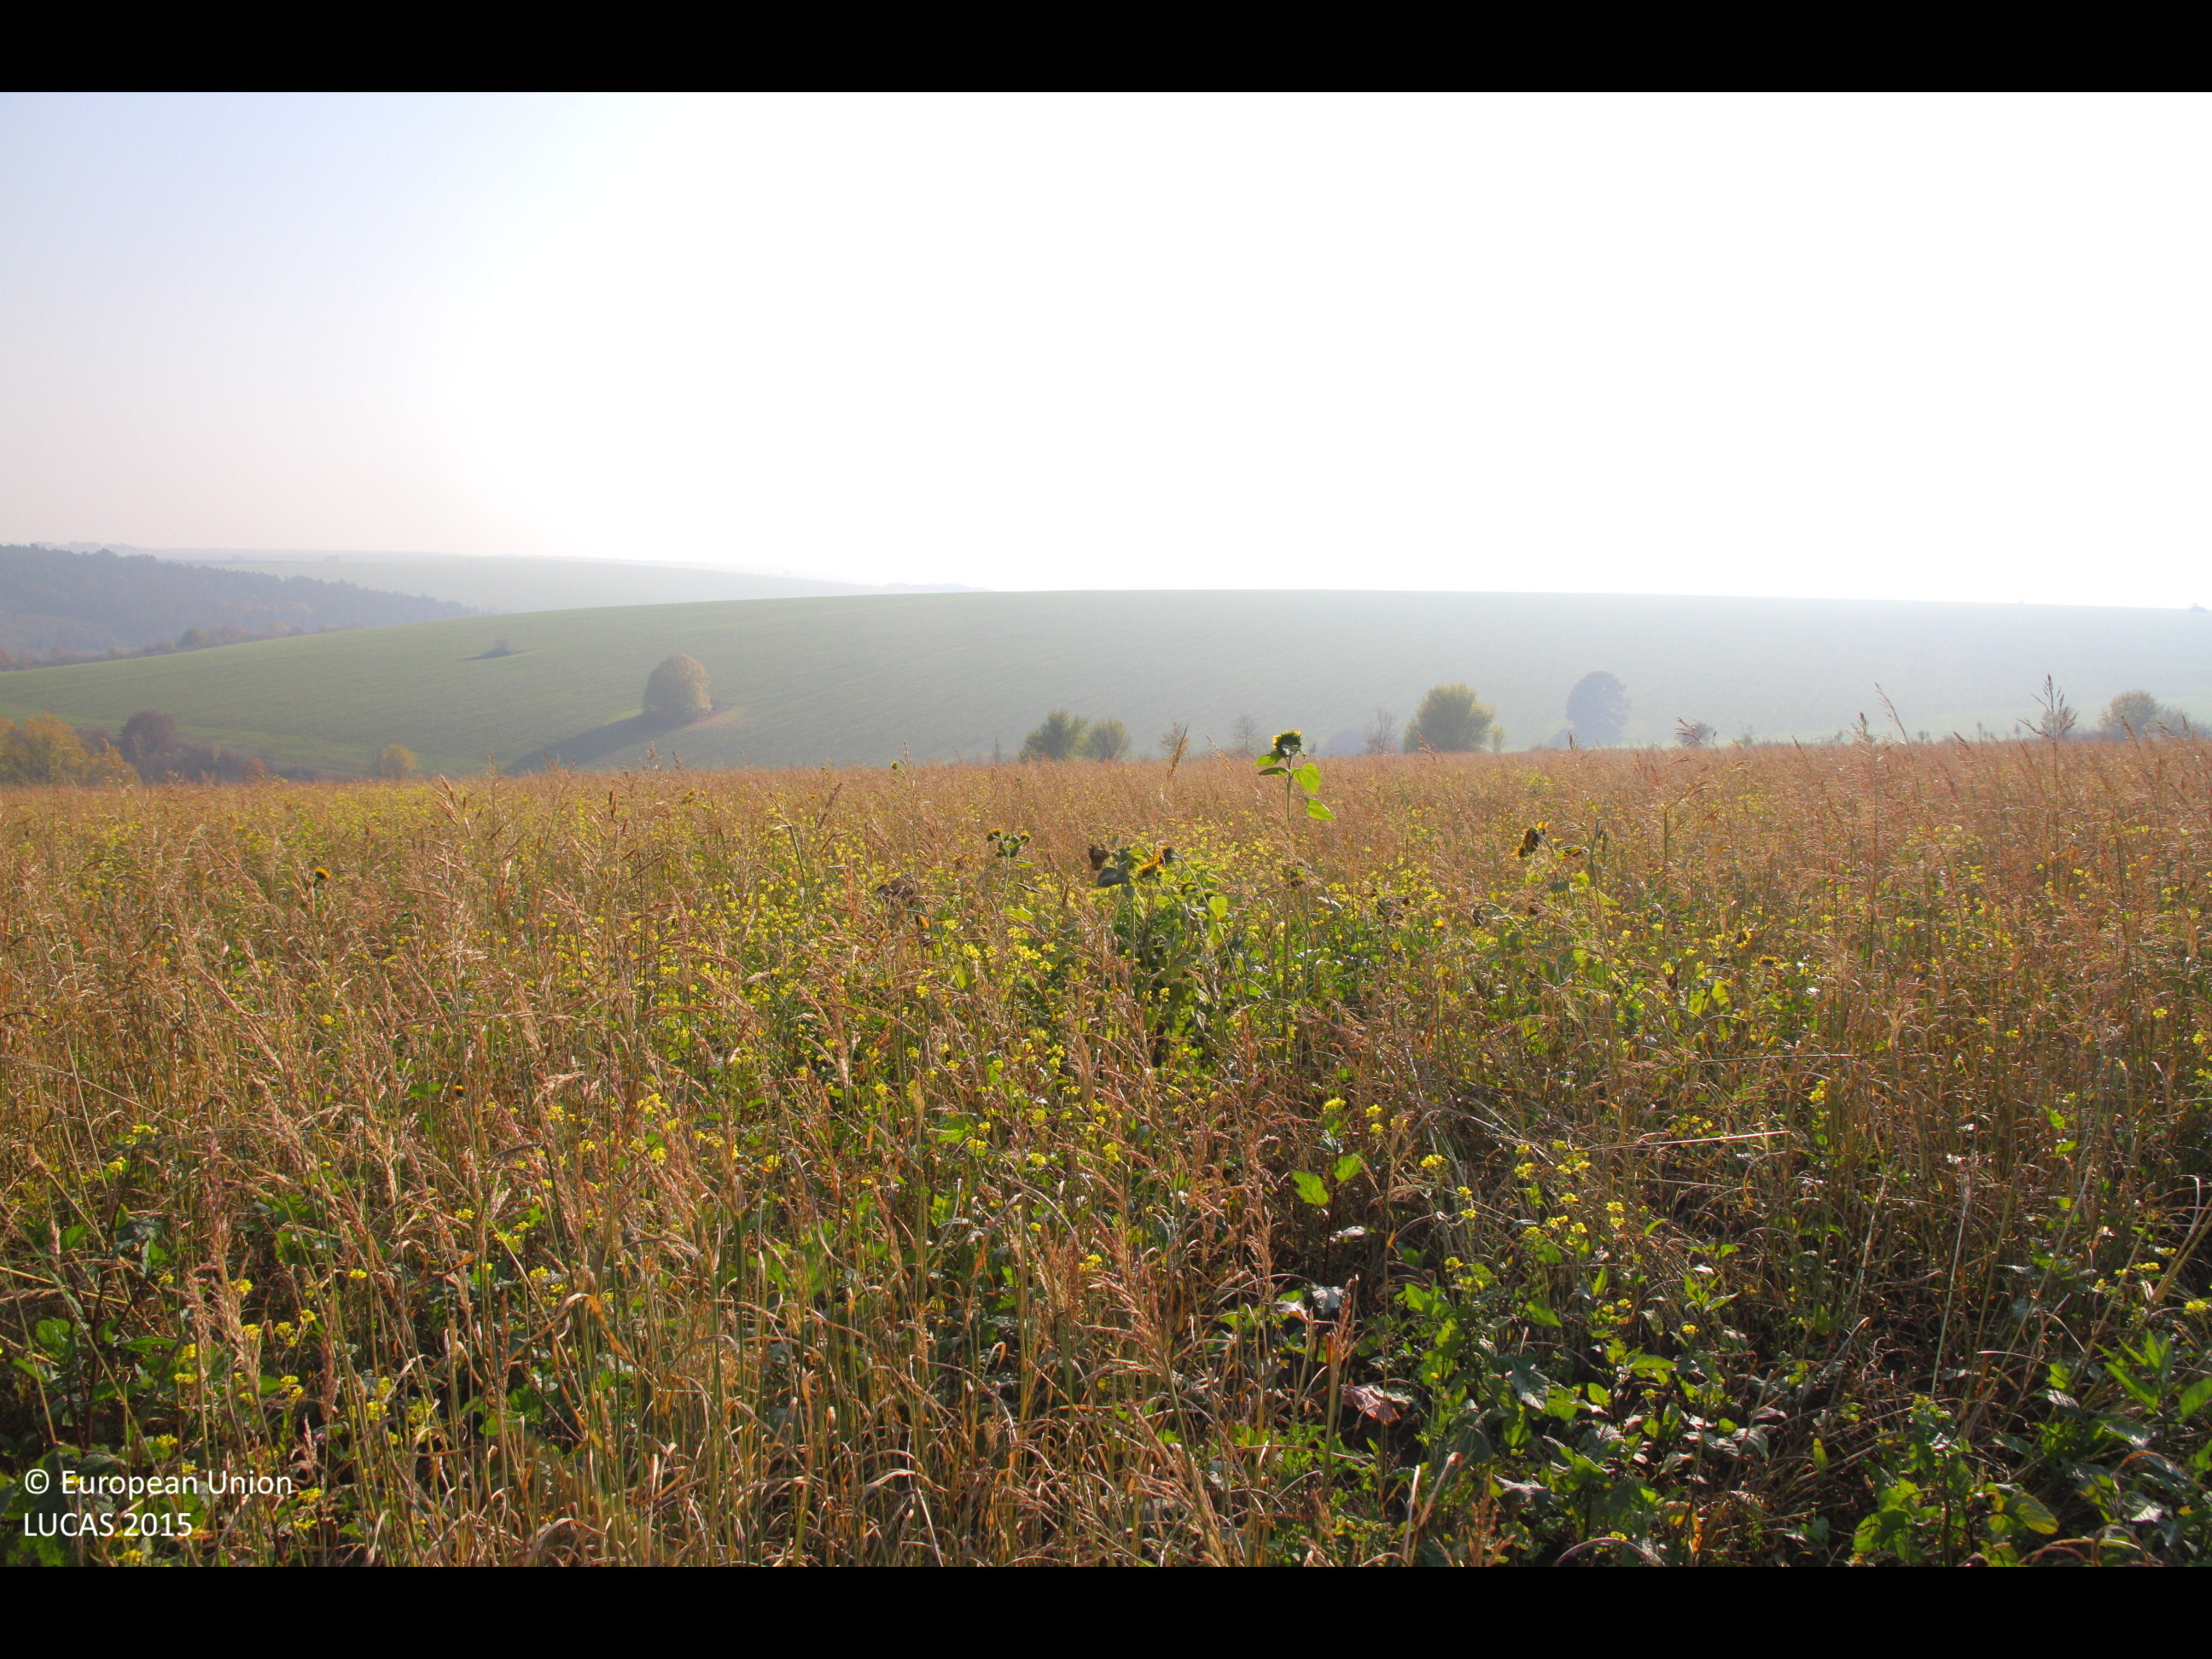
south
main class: Cropland
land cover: Rape and turnip rape
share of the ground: > 75 %
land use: Agriculture (excluding fallow land and kitchen gardens)
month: November
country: BG
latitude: 43.7050
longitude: 26.3473
